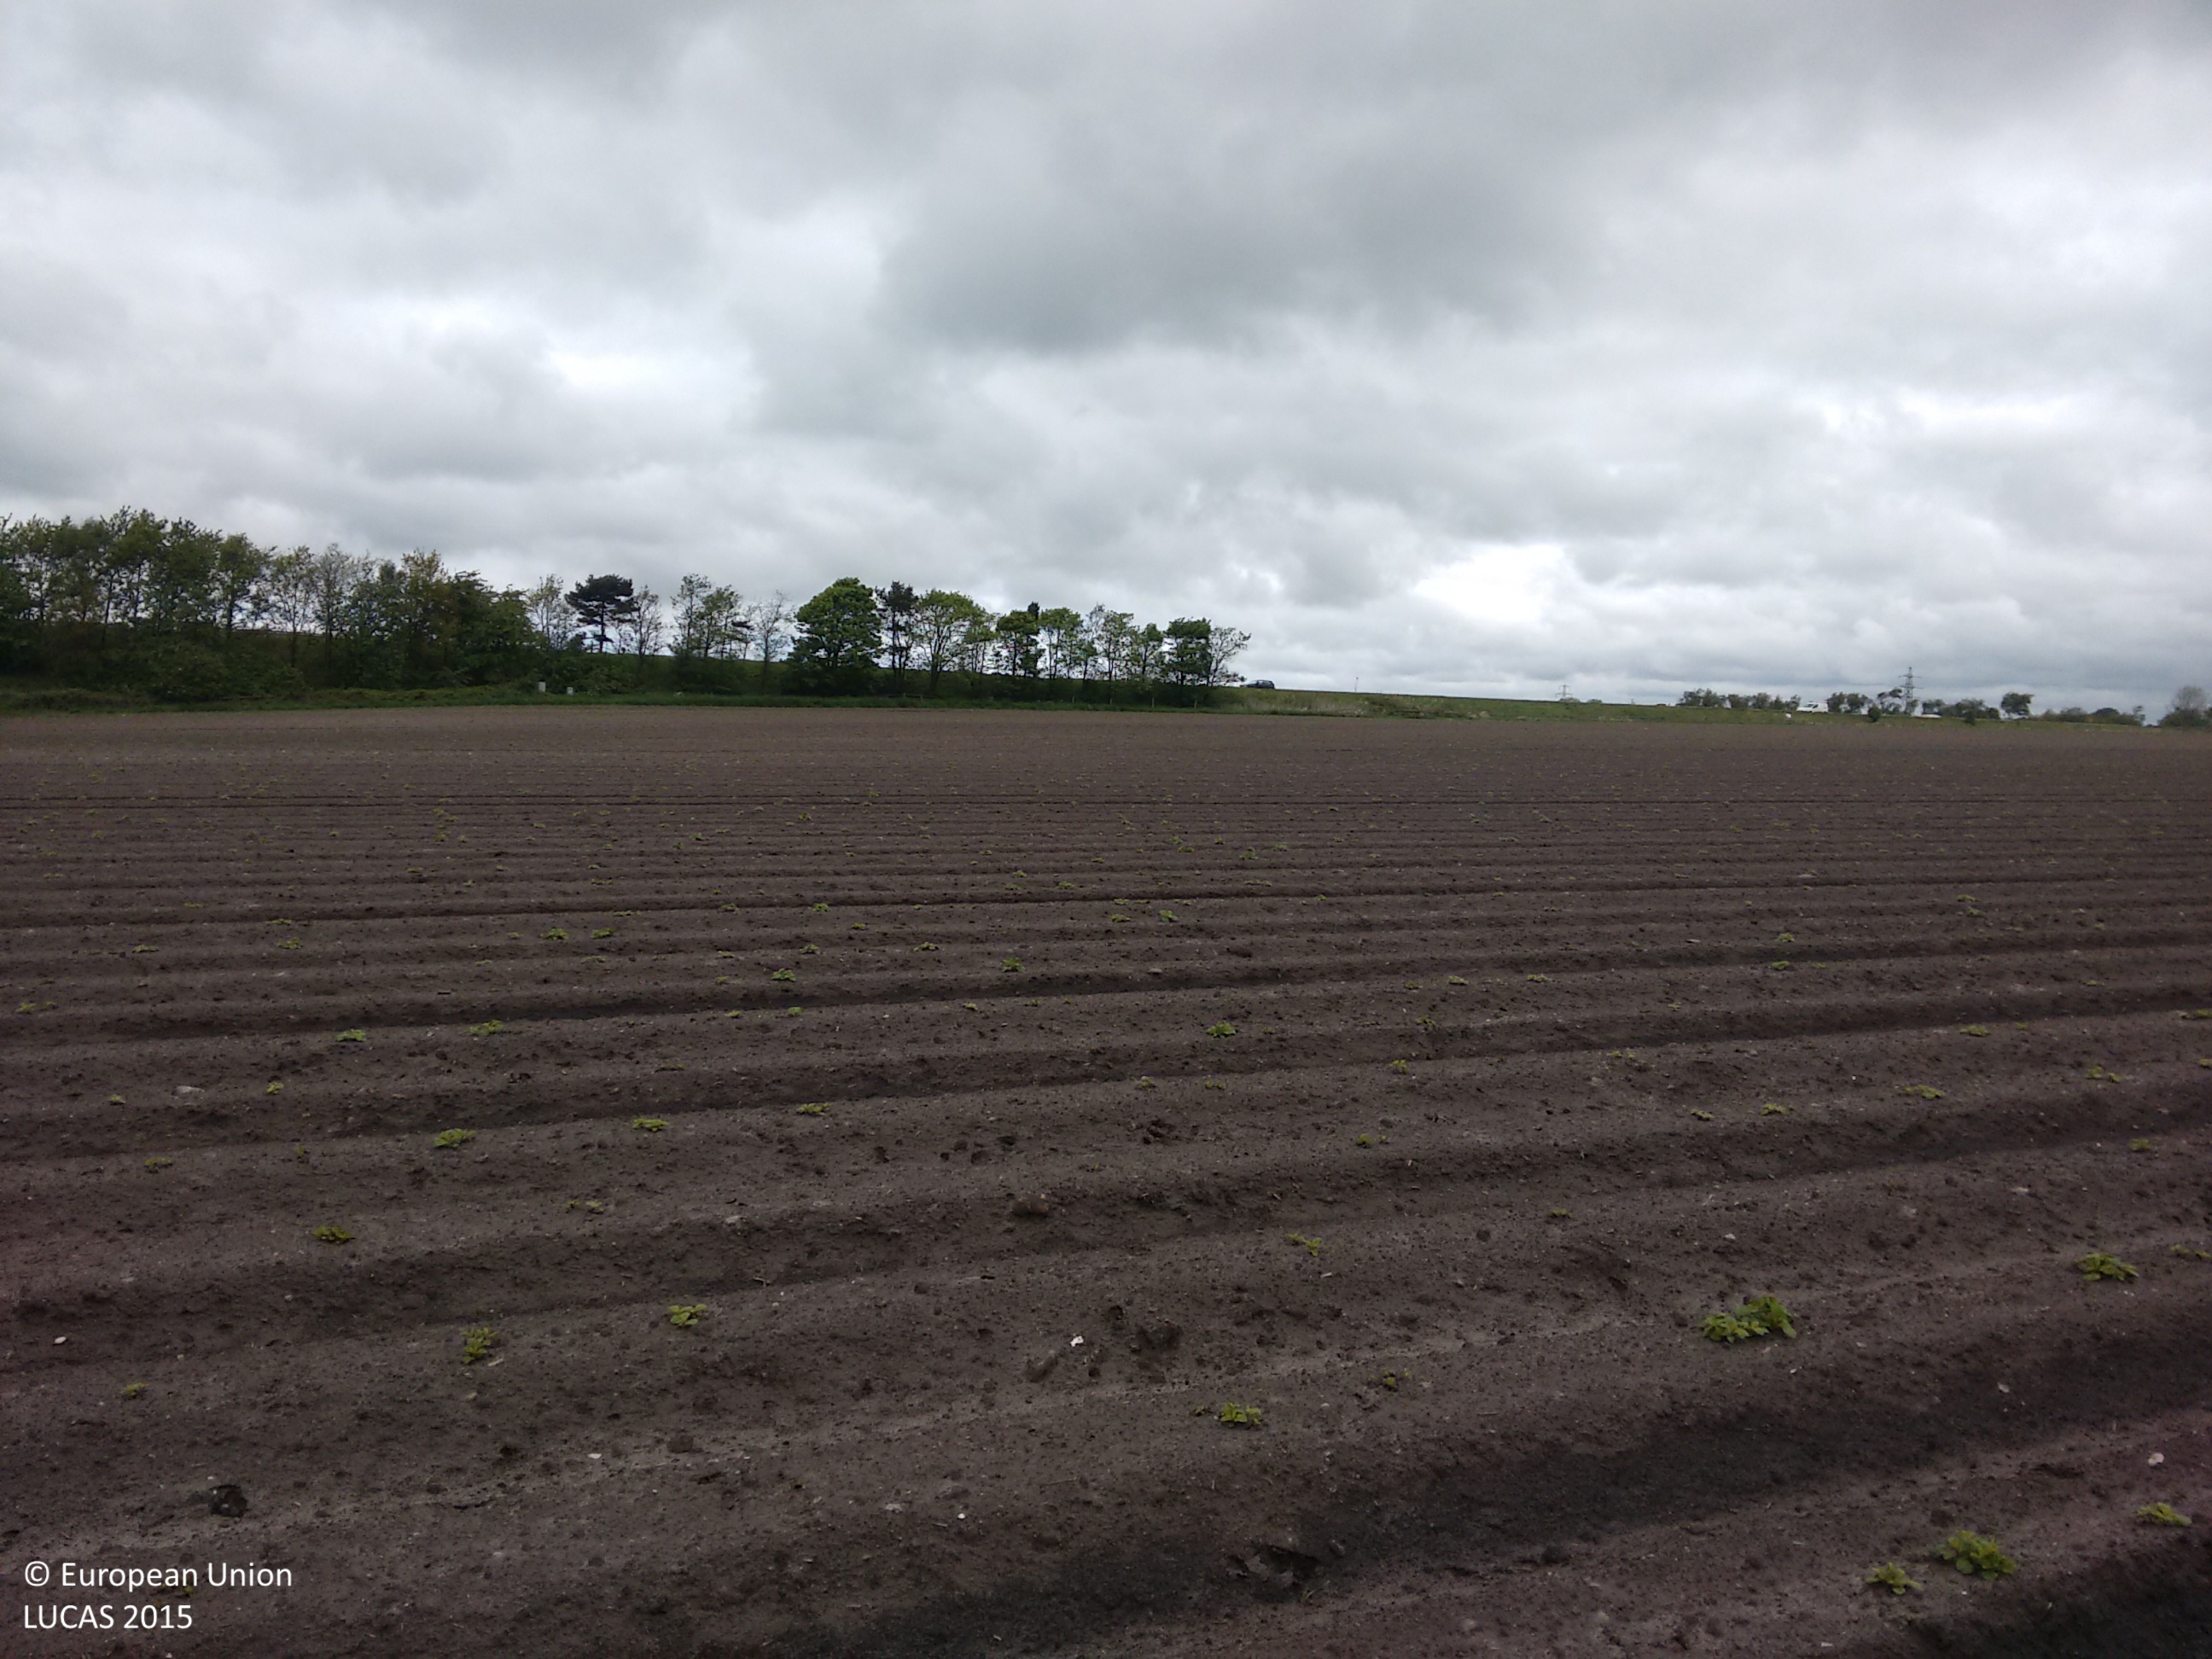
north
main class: Cropland
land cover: Potatoes
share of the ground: < 10 %
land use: Agriculture (excluding fallow land and kitchen gardens)
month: May
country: GB
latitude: 53.5366
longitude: -2.8207
